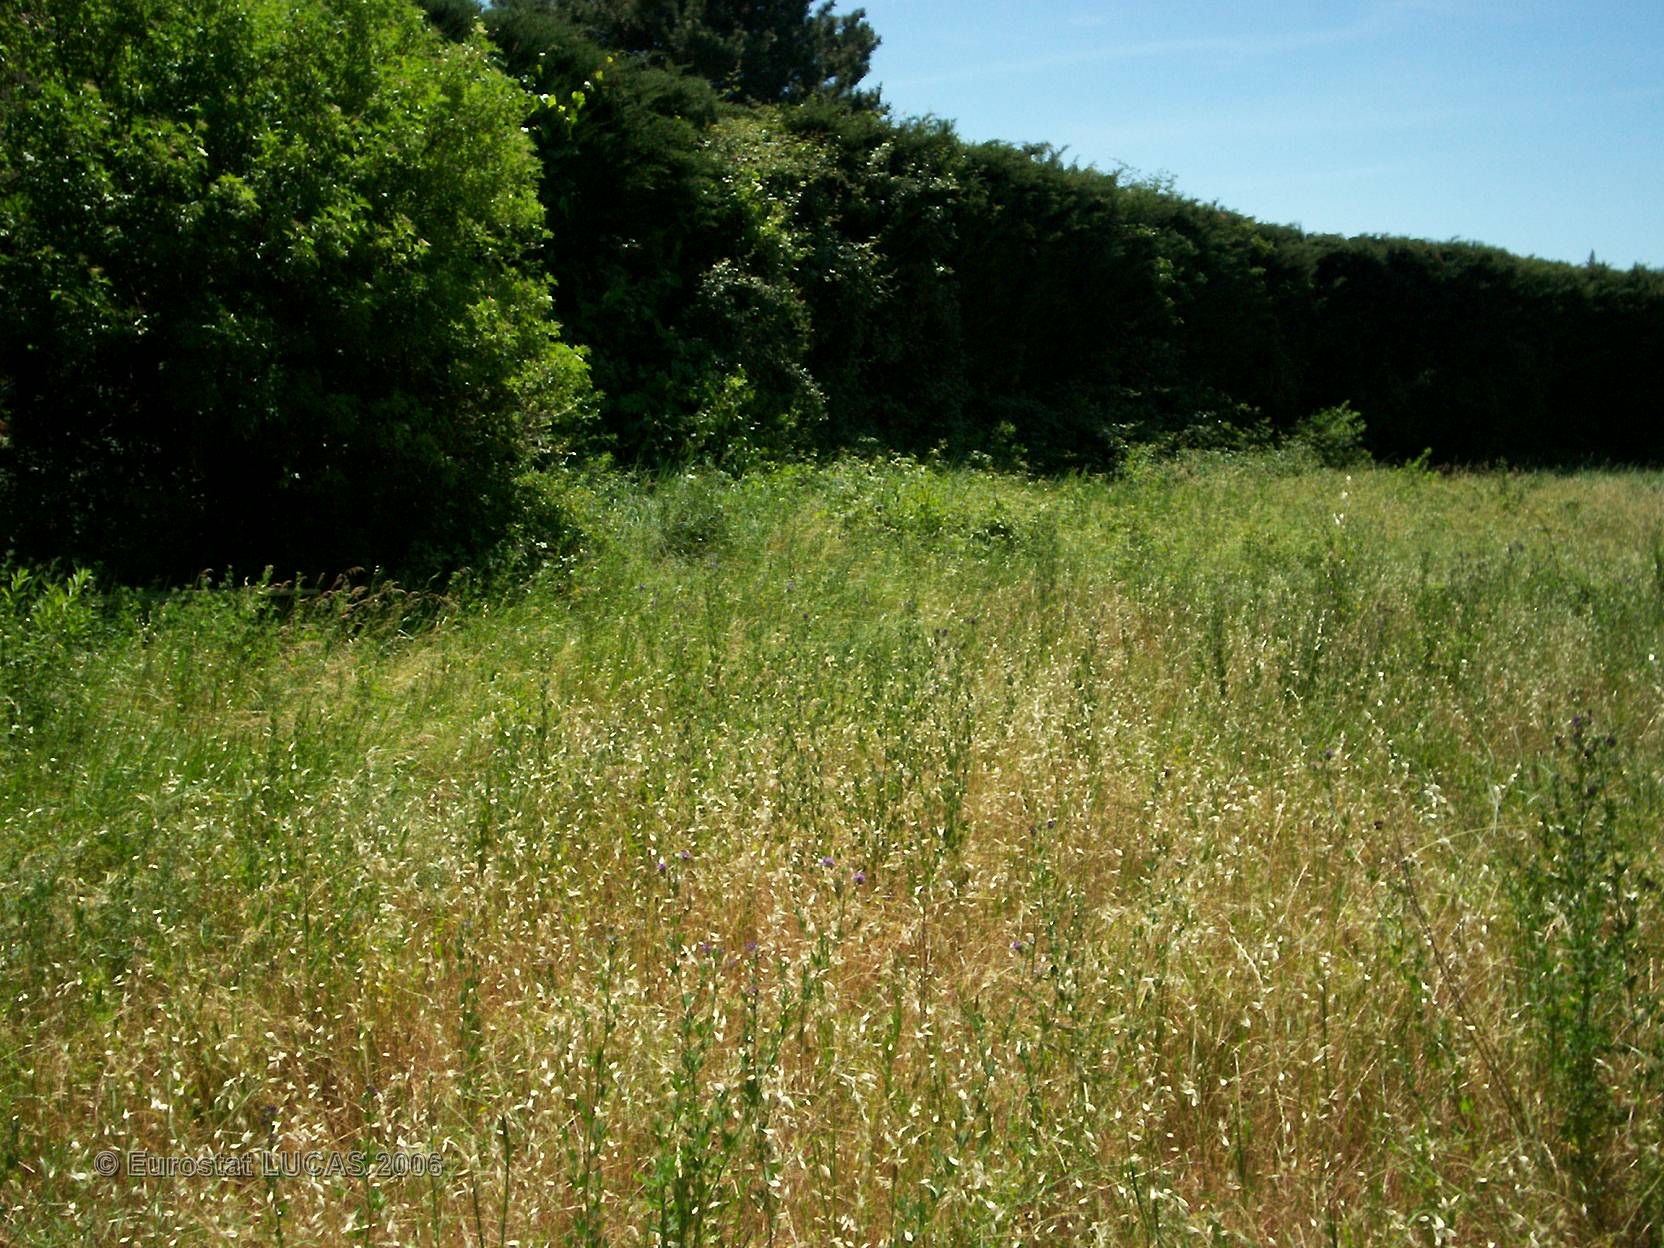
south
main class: Grassland
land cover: Grassland with sparse tree/shrub cover
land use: Unused
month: June
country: FR
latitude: 44.3746
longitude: 4.9998
